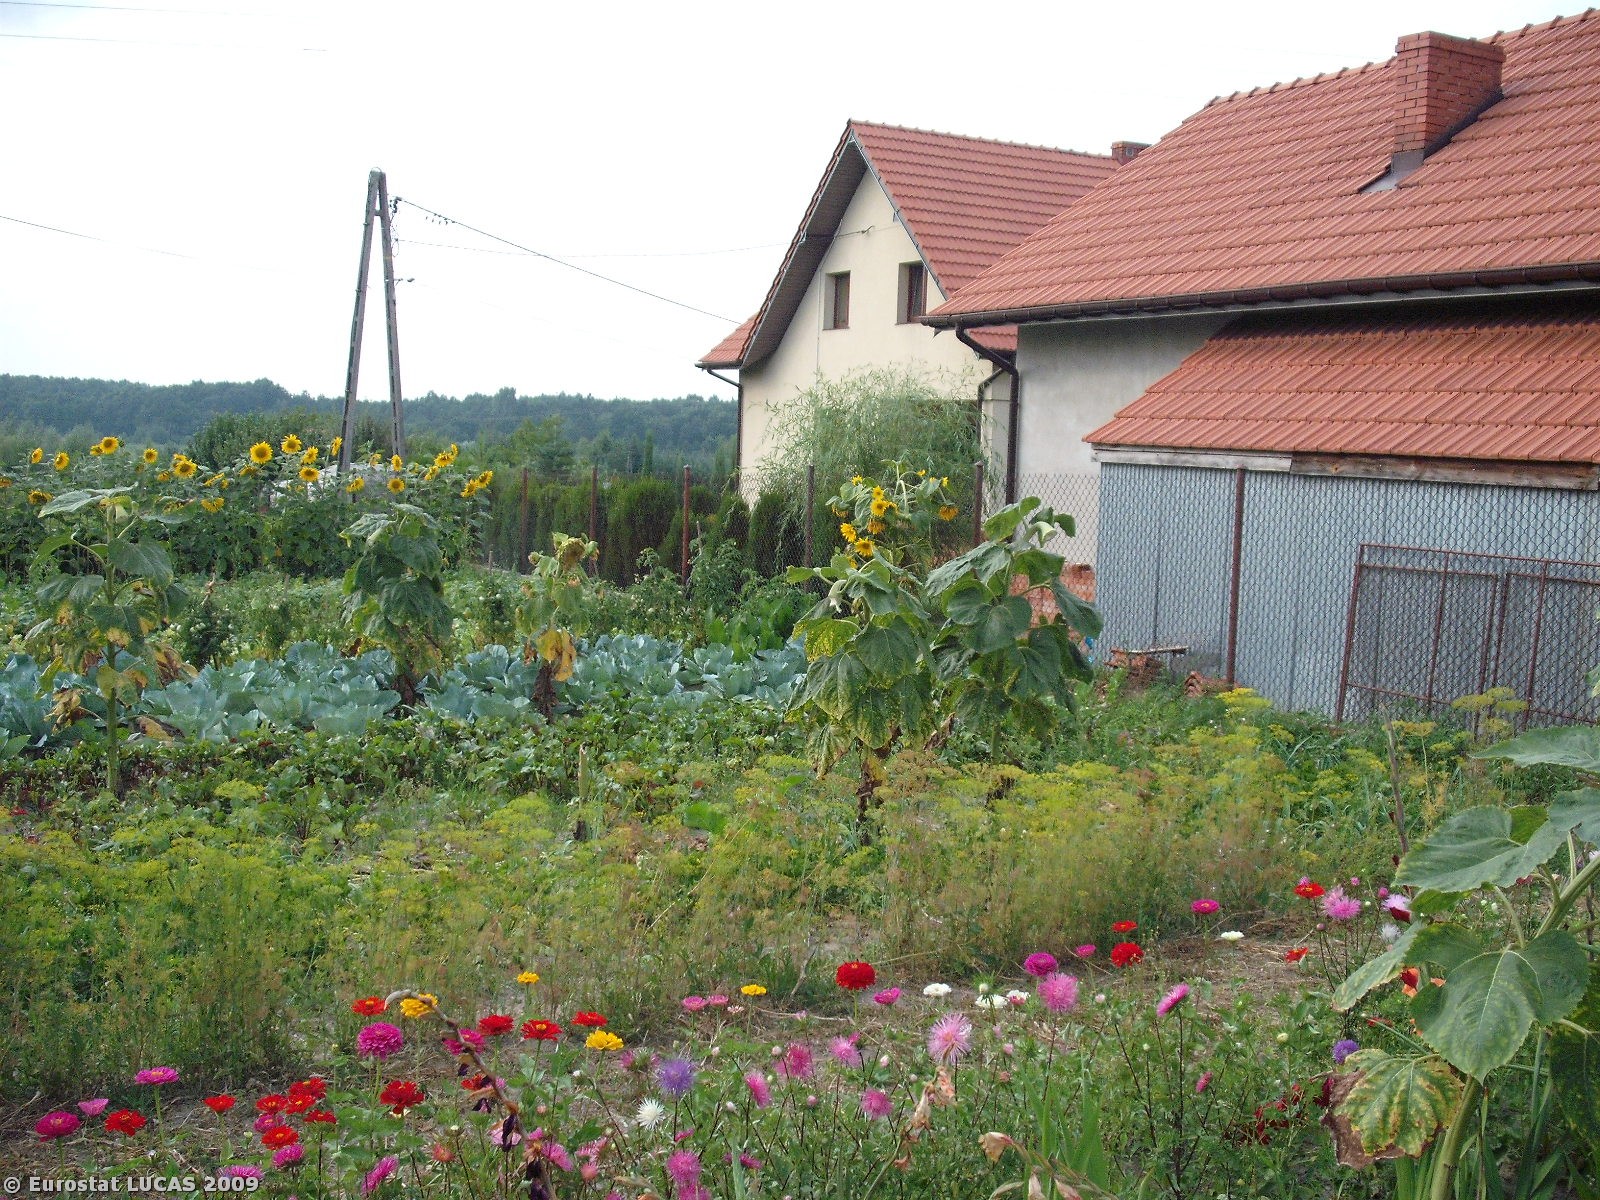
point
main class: Cropland
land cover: Other fresh vegetables
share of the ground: 50 - 75 %
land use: Kitchen garden
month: August
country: PL
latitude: 50.4767
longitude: 20.7076
